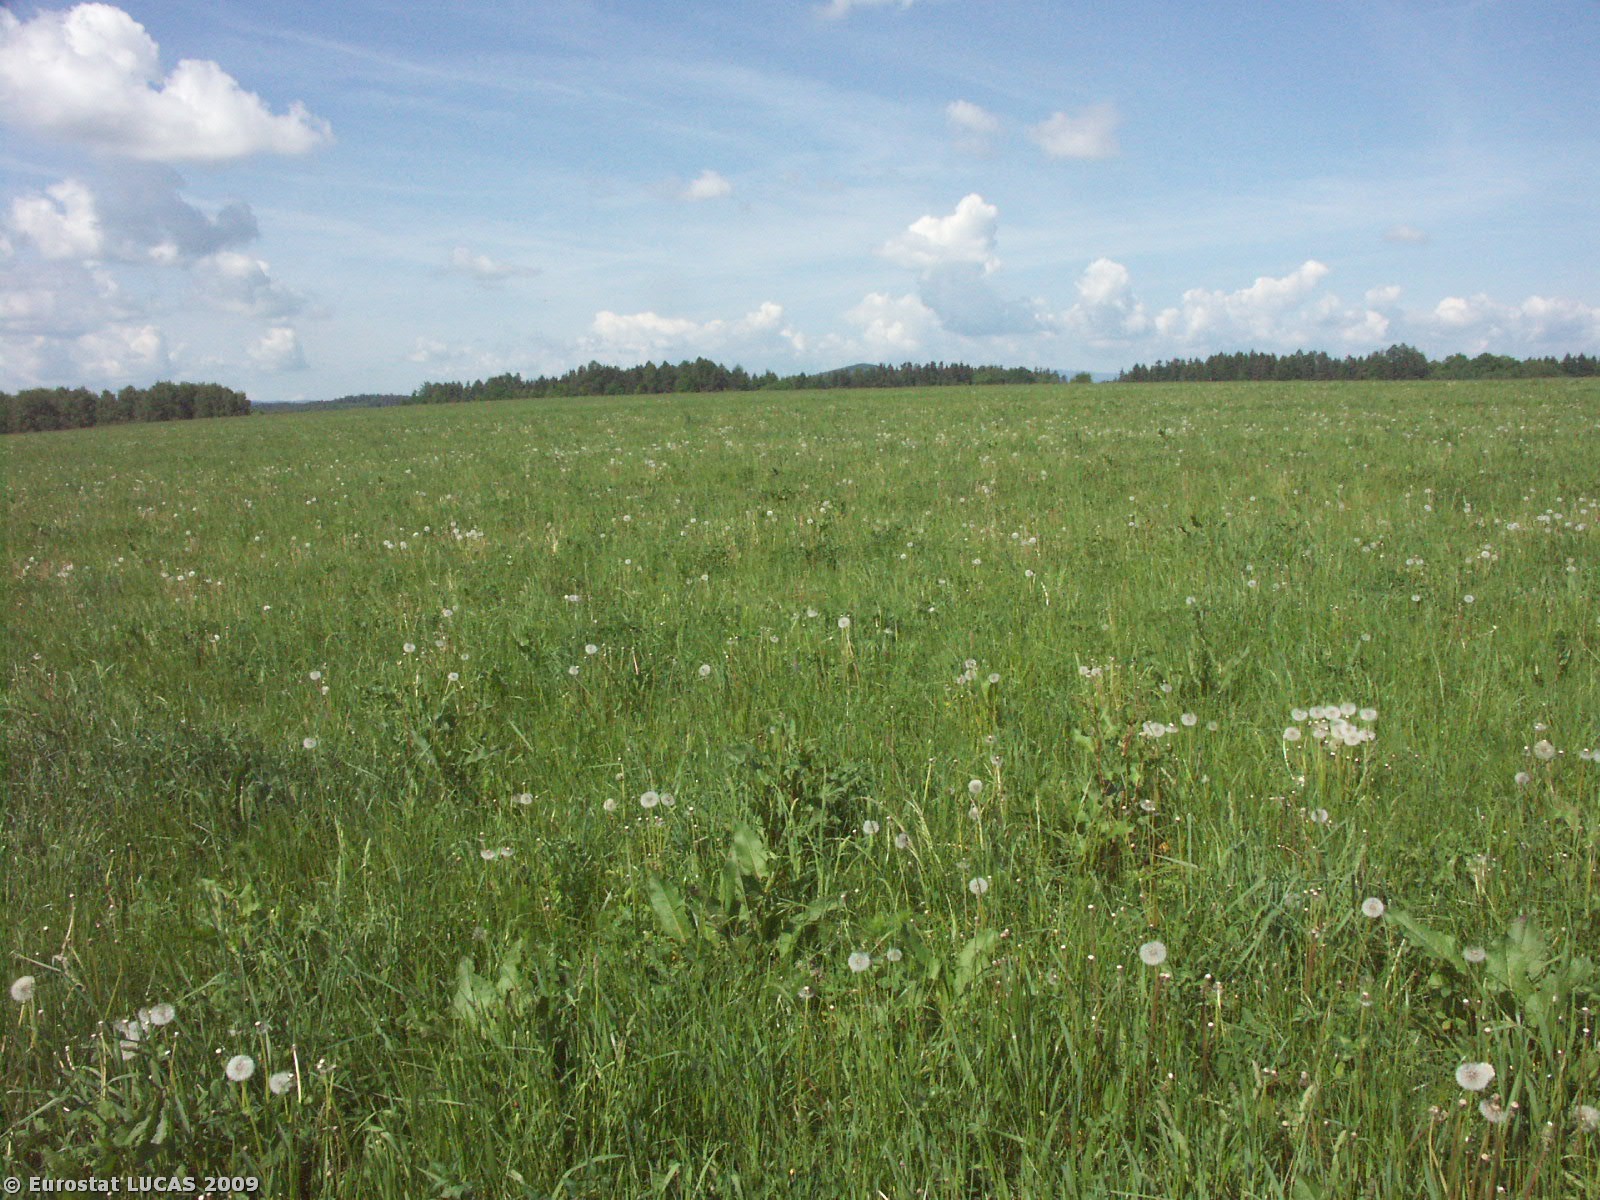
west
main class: Grassland
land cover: Grassland without tree/shrub cover
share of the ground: > 75 %
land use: Agriculture (excluding fallow land and kitchen gardens)
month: May
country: CZ
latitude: 48.8476
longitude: 14.6209
